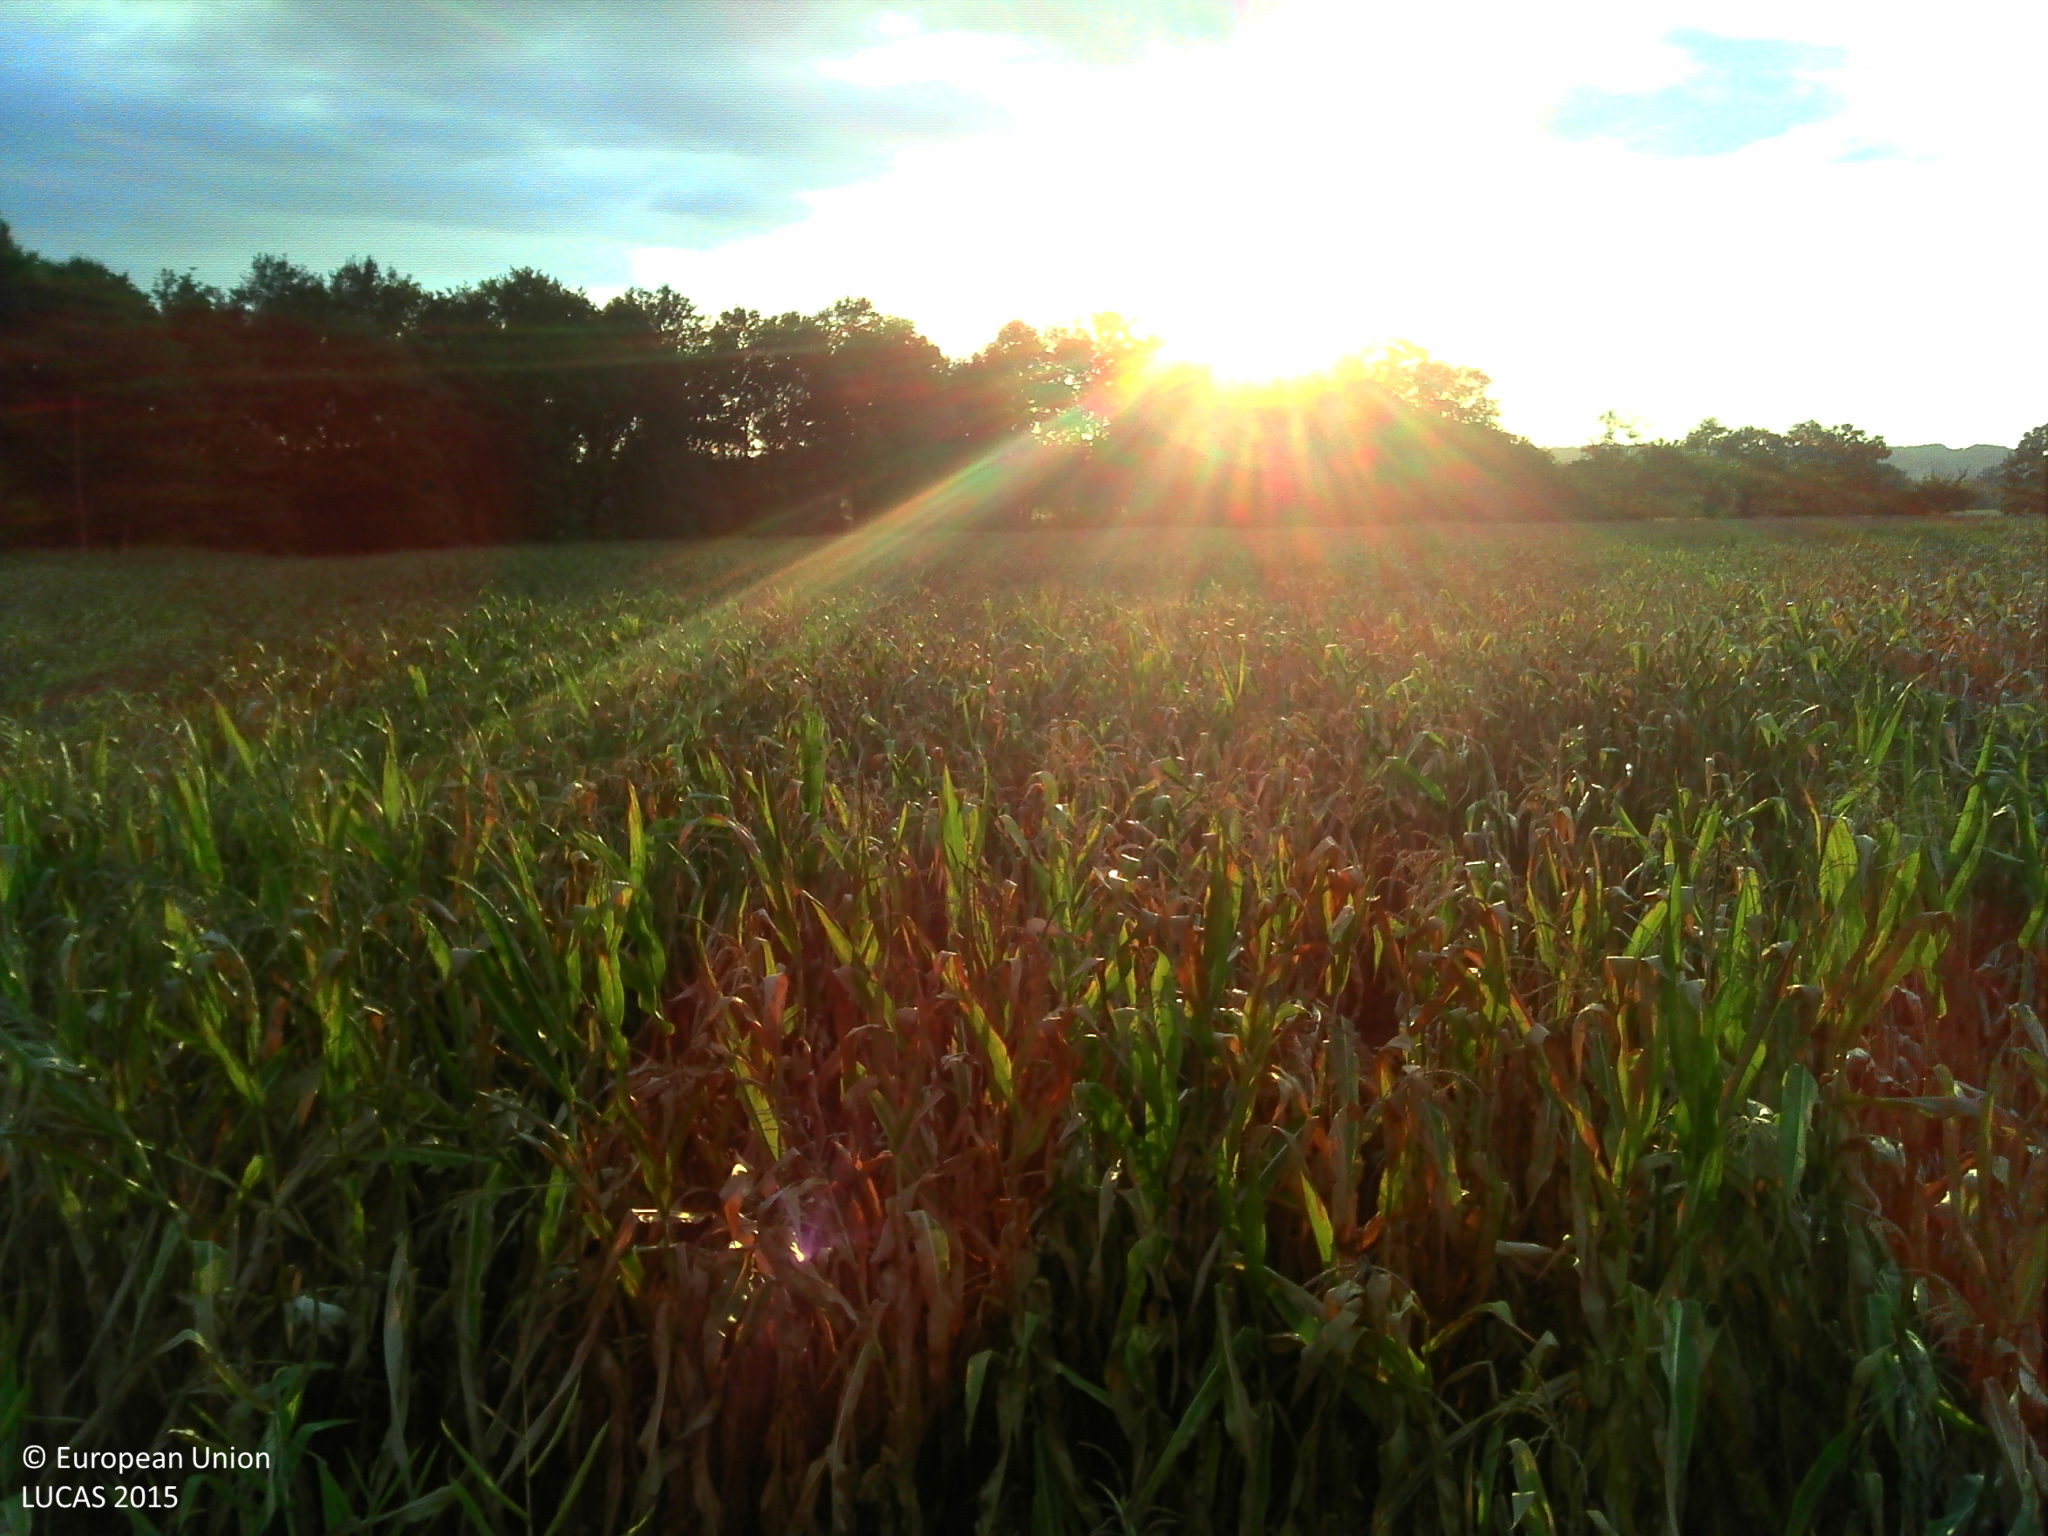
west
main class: Cropland
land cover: Maize
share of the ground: > 75 %
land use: Agriculture (excluding fallow land and kitchen gardens)
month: September
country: FR
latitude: 43.3864
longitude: -0.4389
